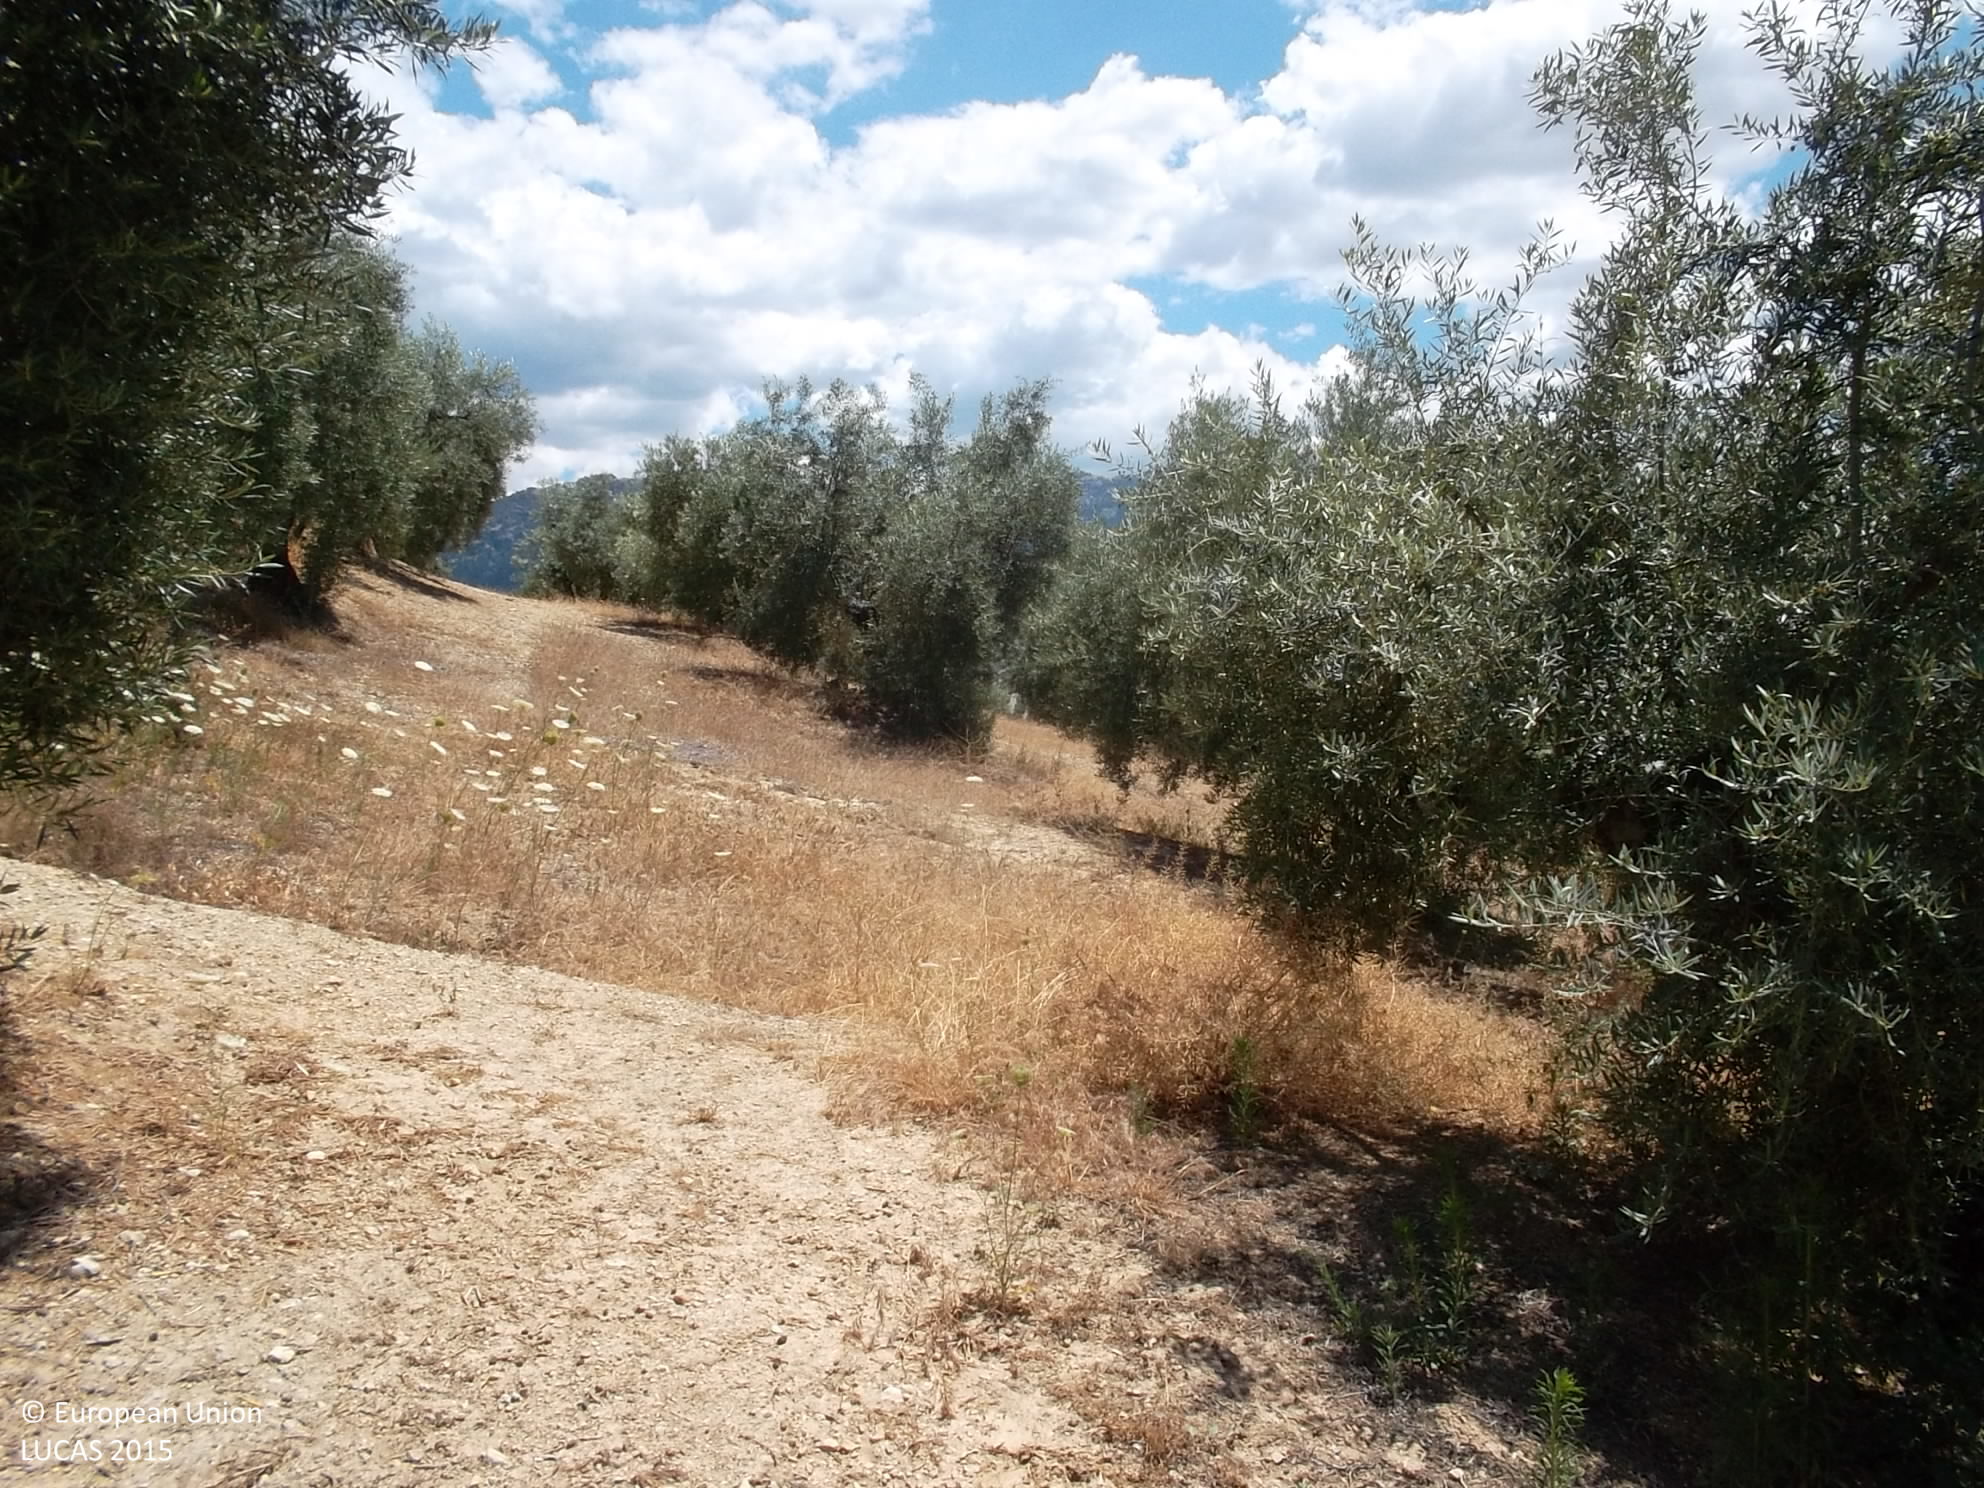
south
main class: Cropland
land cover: Olive groves
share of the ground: 50 - 75 %
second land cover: Other bare soil
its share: > 75 %
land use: Agriculture (excluding fallow land and kitchen gardens)
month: June
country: ES
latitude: 37.9718
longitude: -2.9845
